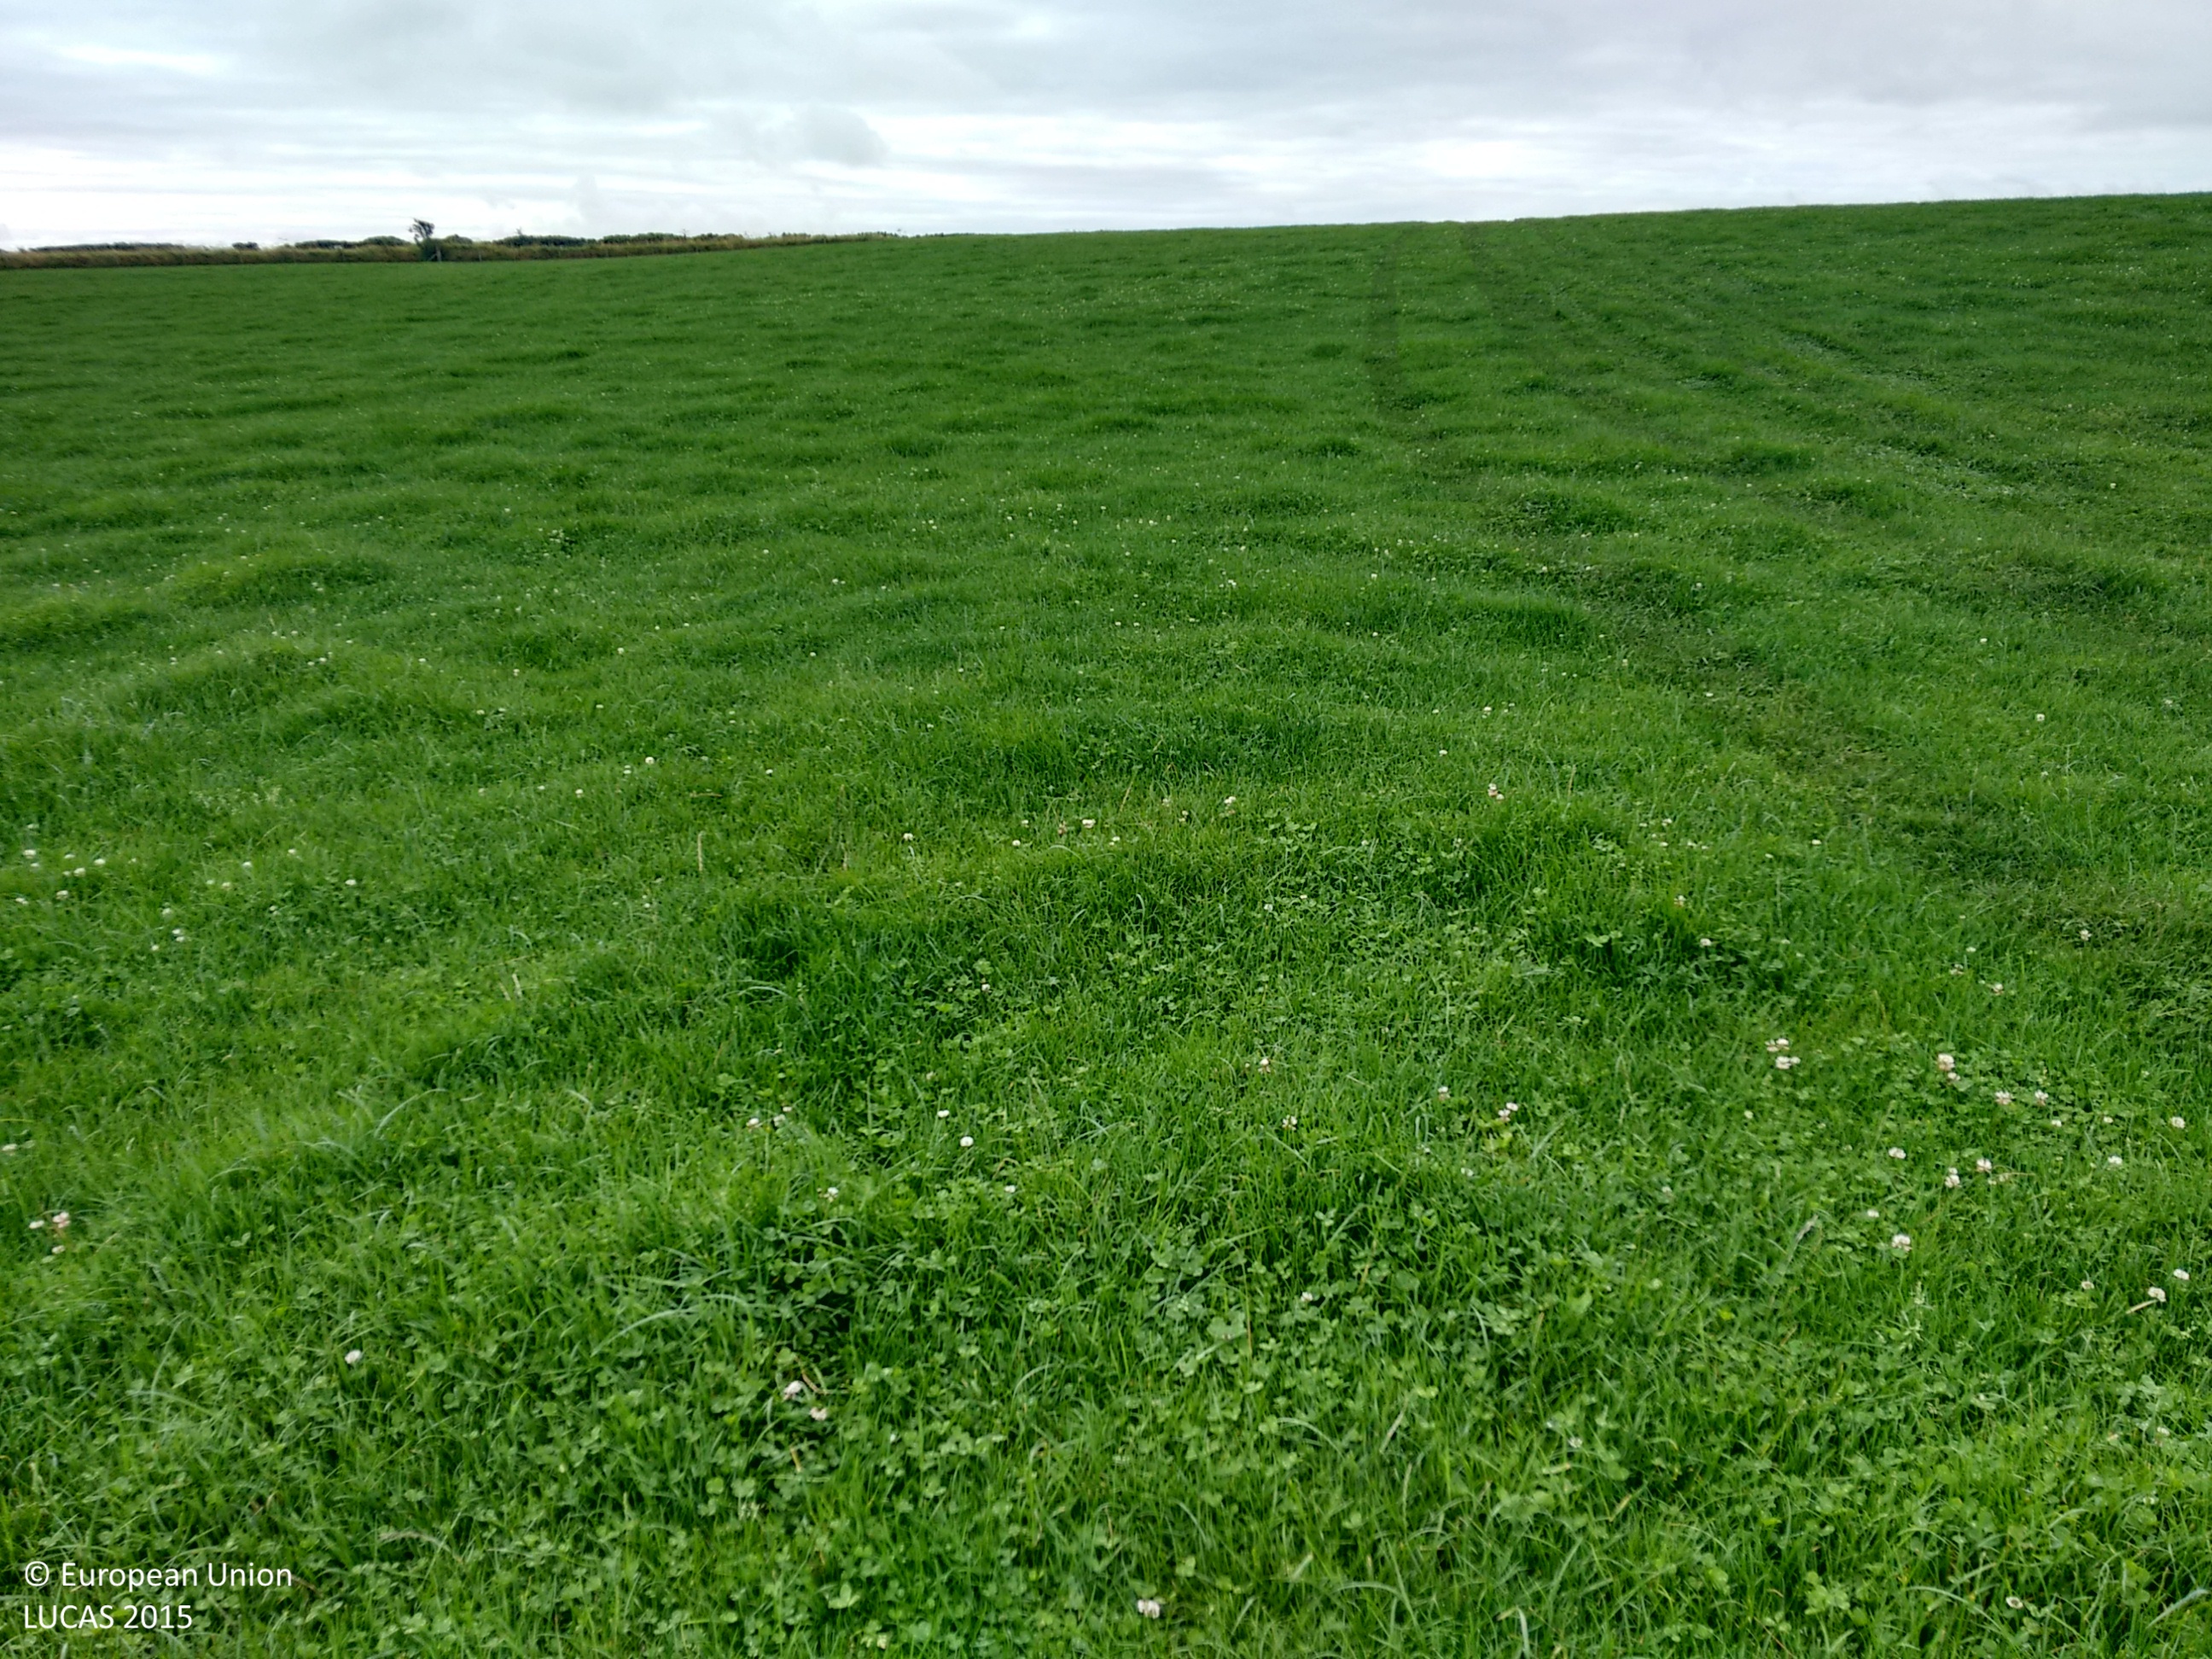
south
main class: Grassland
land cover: Grassland without tree/shrub cover
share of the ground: > 75 %
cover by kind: herbaceous plants 100 %
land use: Agriculture (excluding fallow land and kitchen gardens)
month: August
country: GB
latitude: 54.8462
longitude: -4.9543
